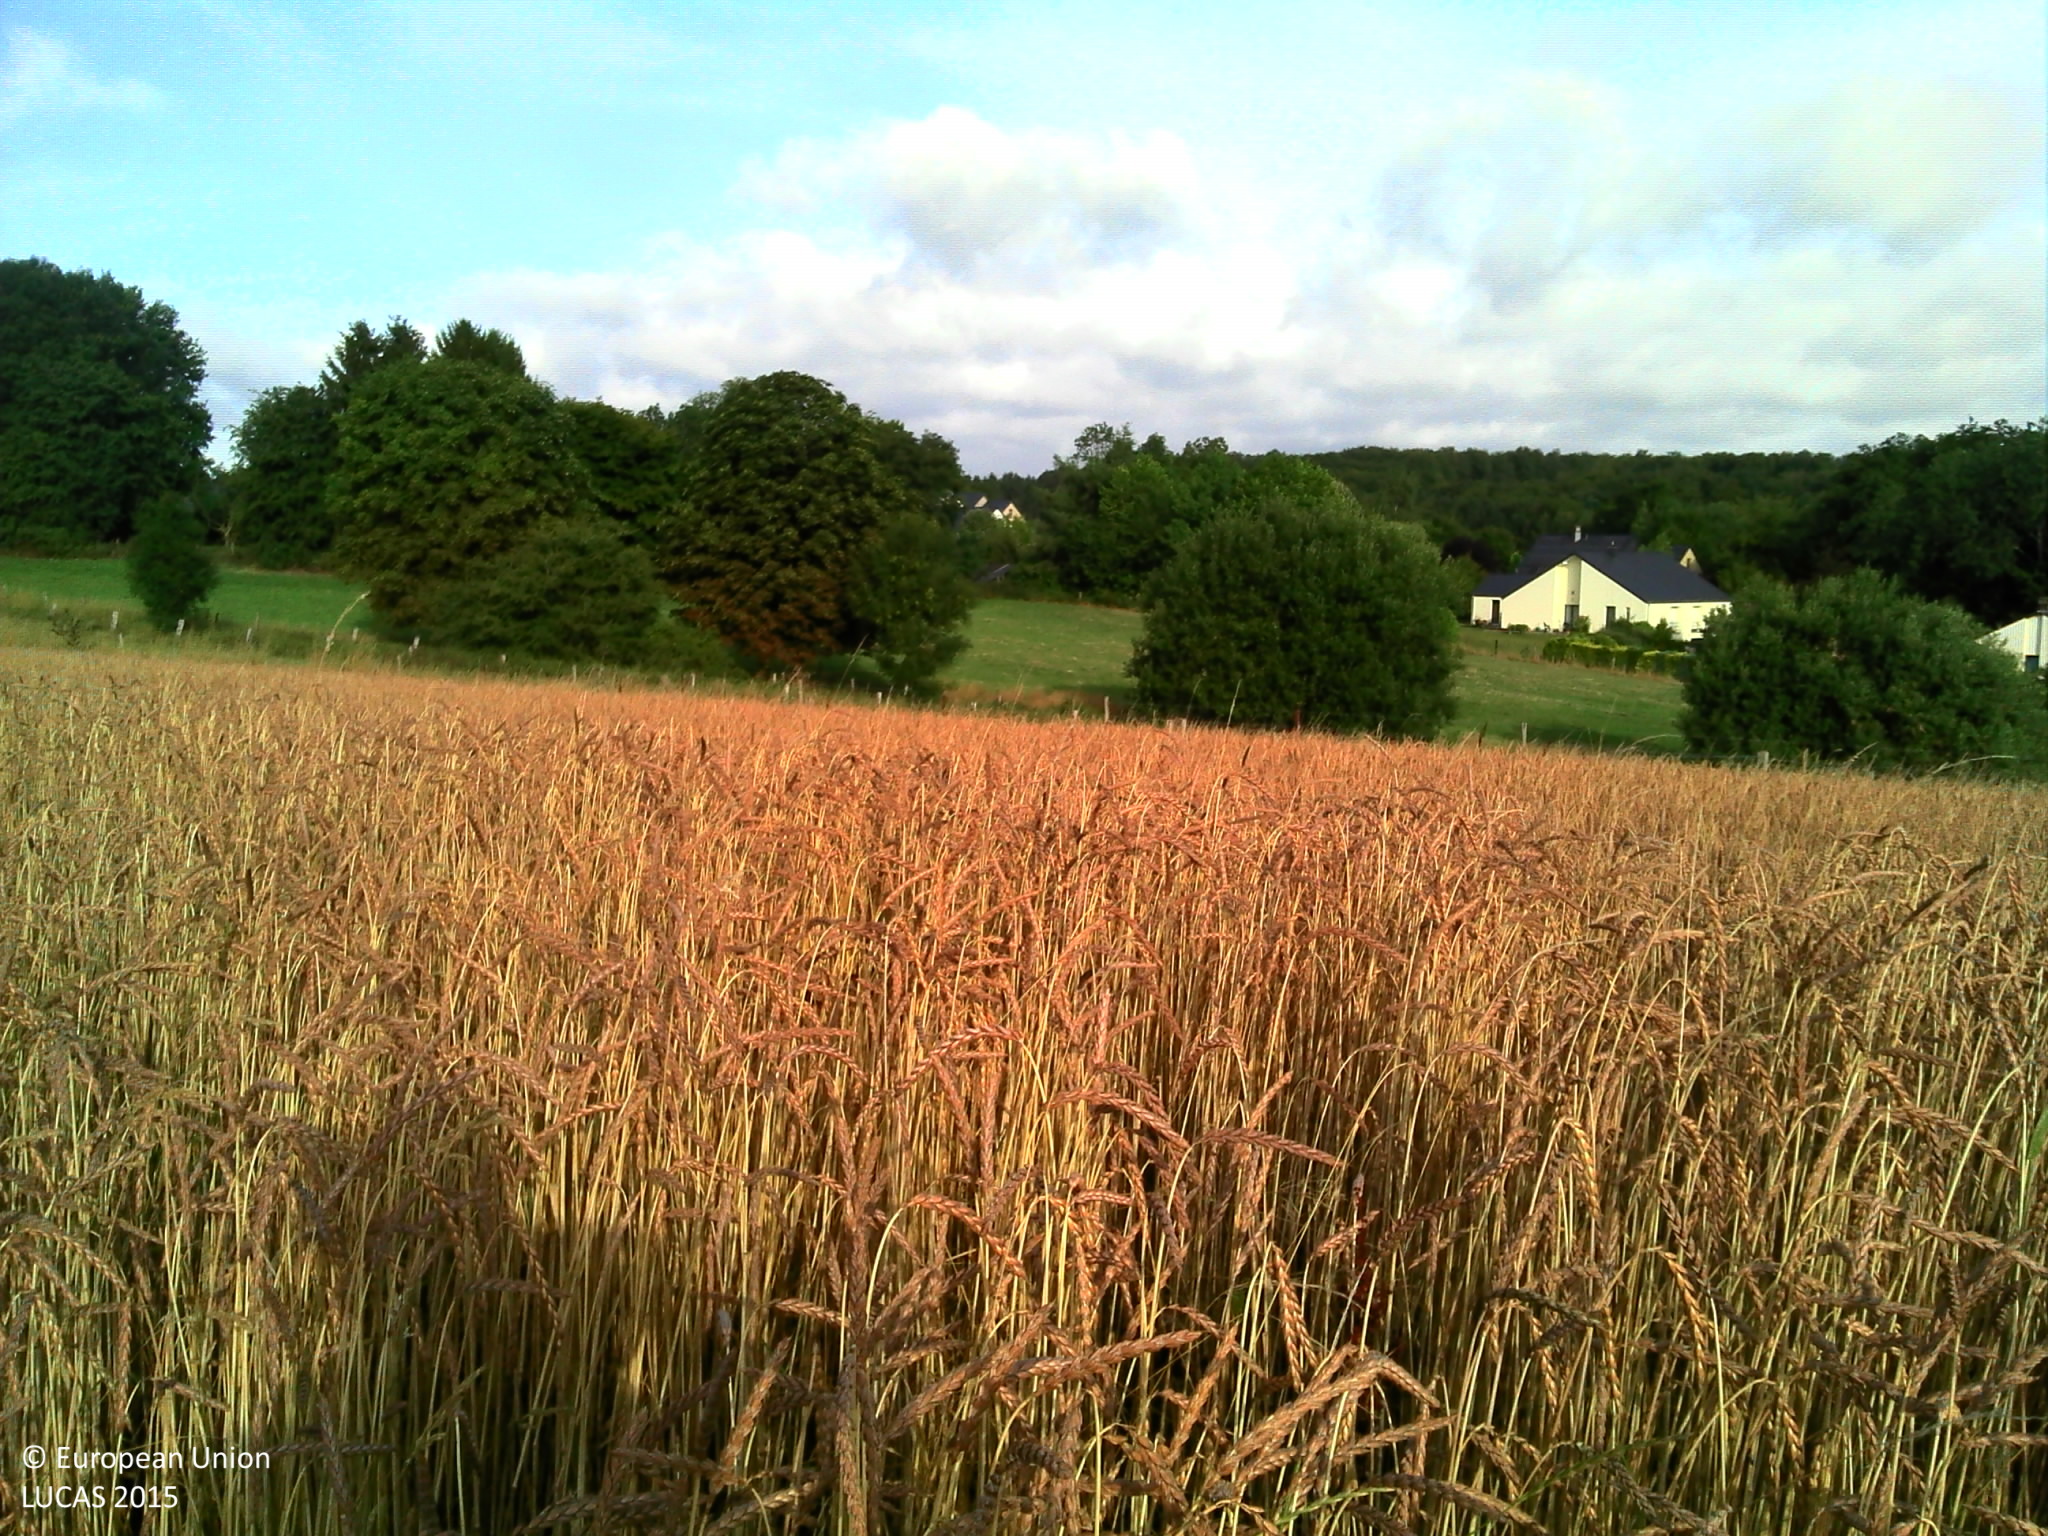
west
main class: Grassland
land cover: Grassland without tree/shrub cover
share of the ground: > 75 %
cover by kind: herbaceous plants 100 %
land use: Agriculture (excluding fallow land and kitchen gardens)
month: July
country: BE
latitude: 49.7117
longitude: 5.8247
